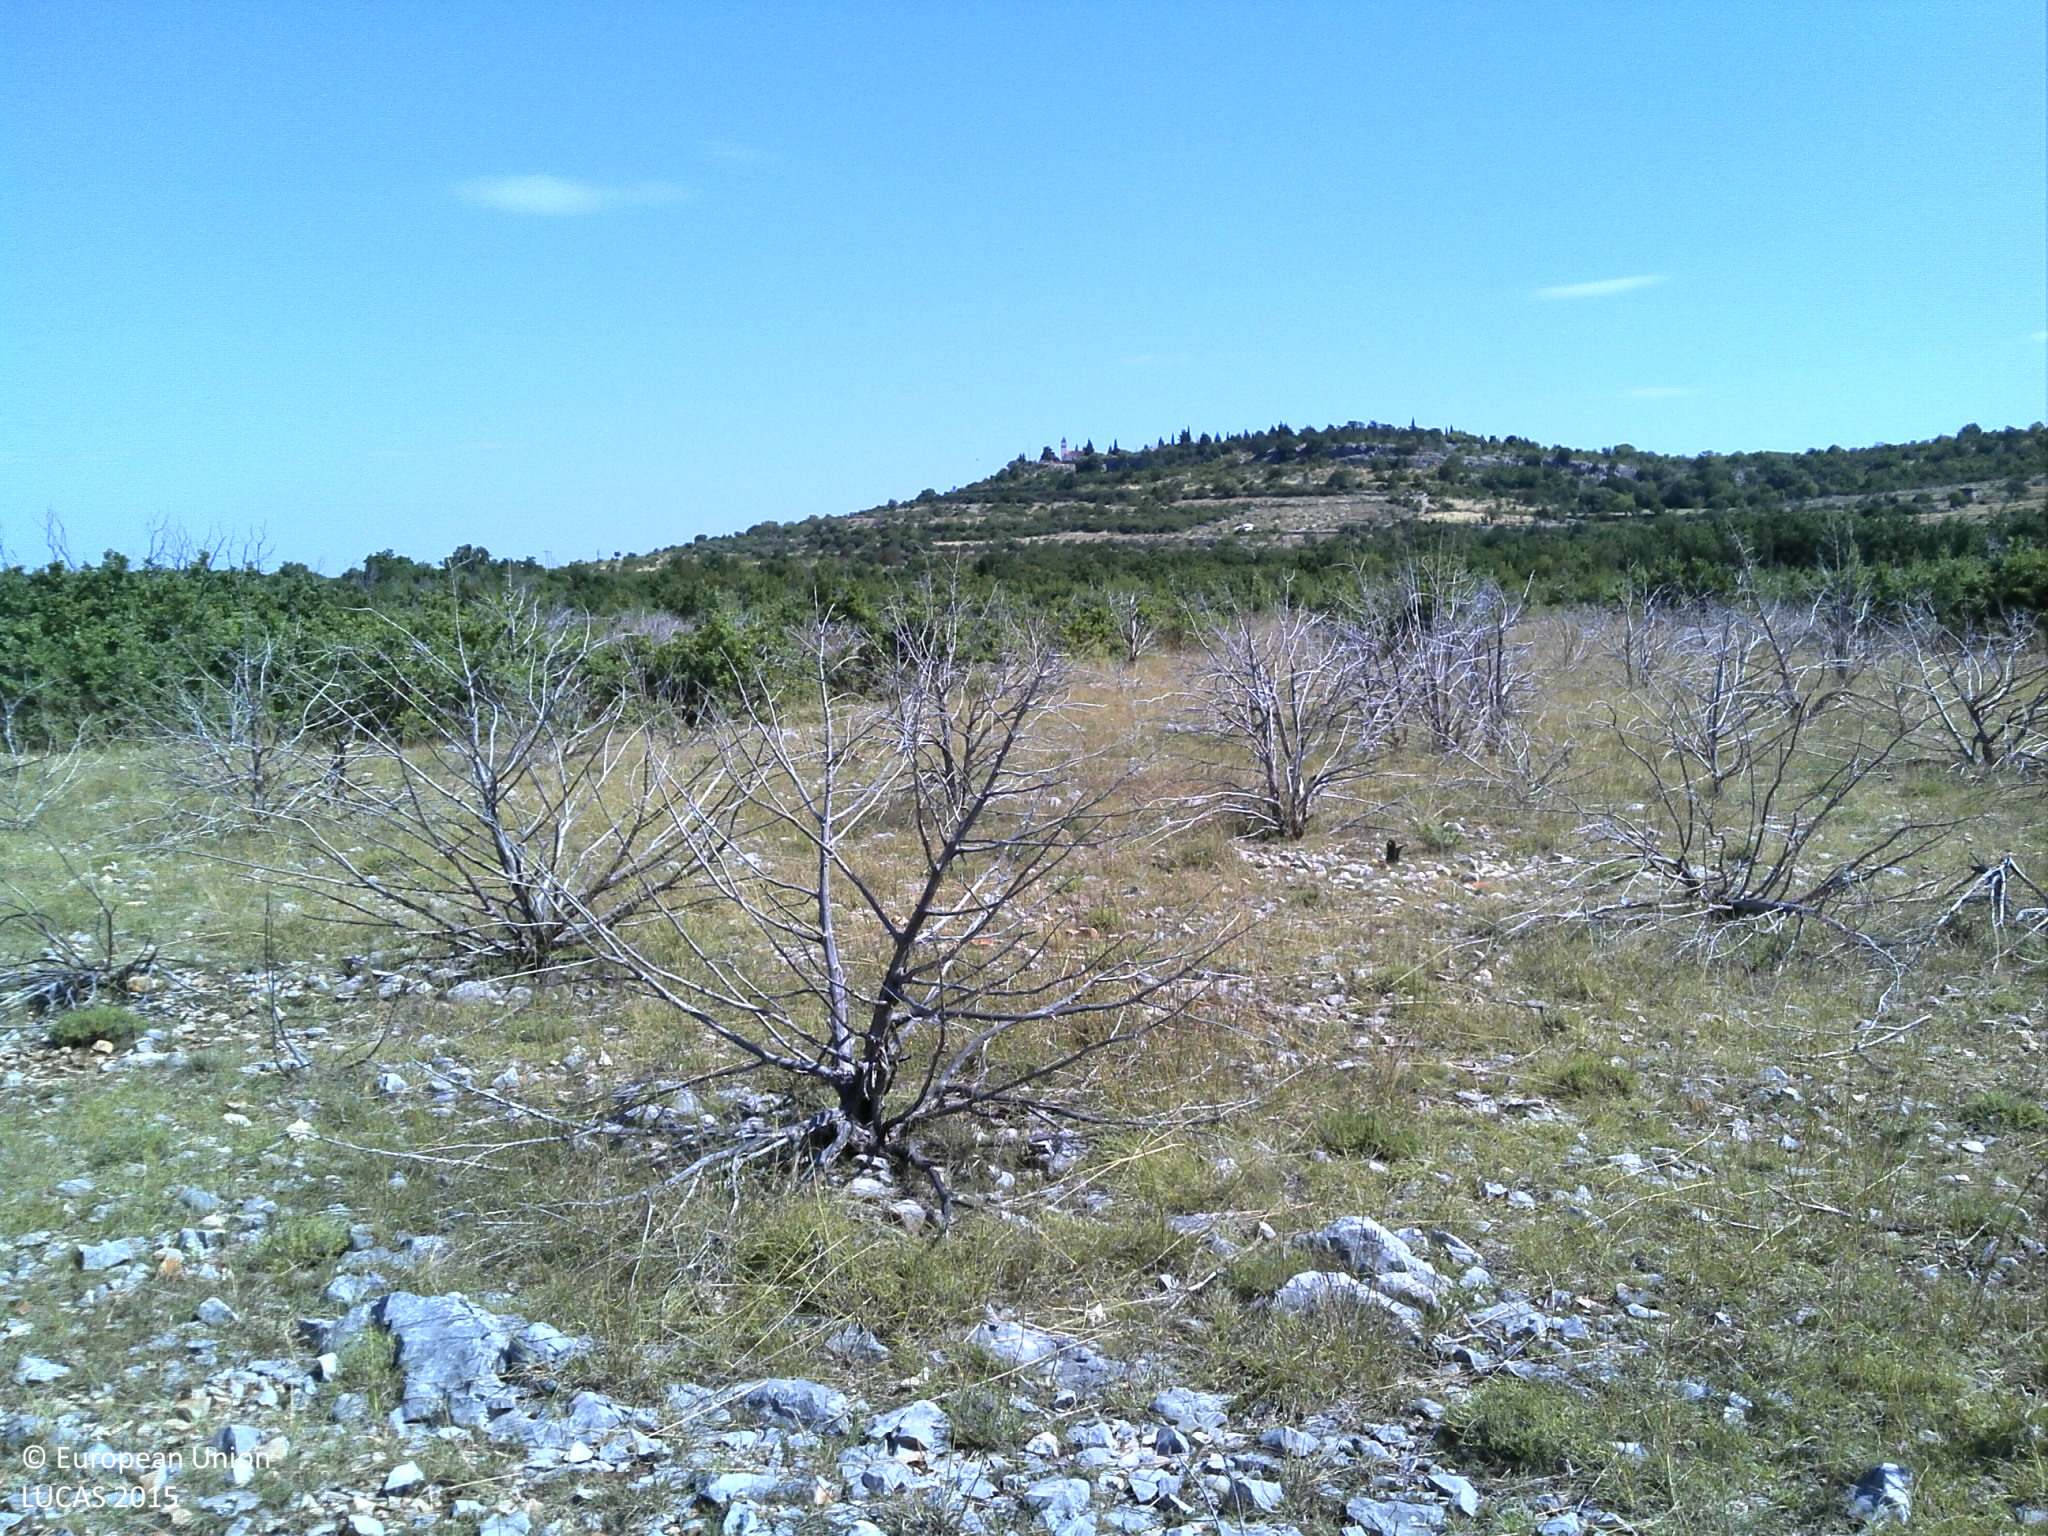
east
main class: Shrubland
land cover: Shrubland without tree cover
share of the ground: 25 - 50 %
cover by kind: herbaceous plants 40 %, shrubs 30 %, unconsolidated bare surface 25 %, consolidated bare surface 5 %
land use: Semi-natural and natural areas not in use
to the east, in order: Shrubland without tree cover; Tracks; Shrubland without tree cover
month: July
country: HR
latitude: 43.7931
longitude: 16.0686
